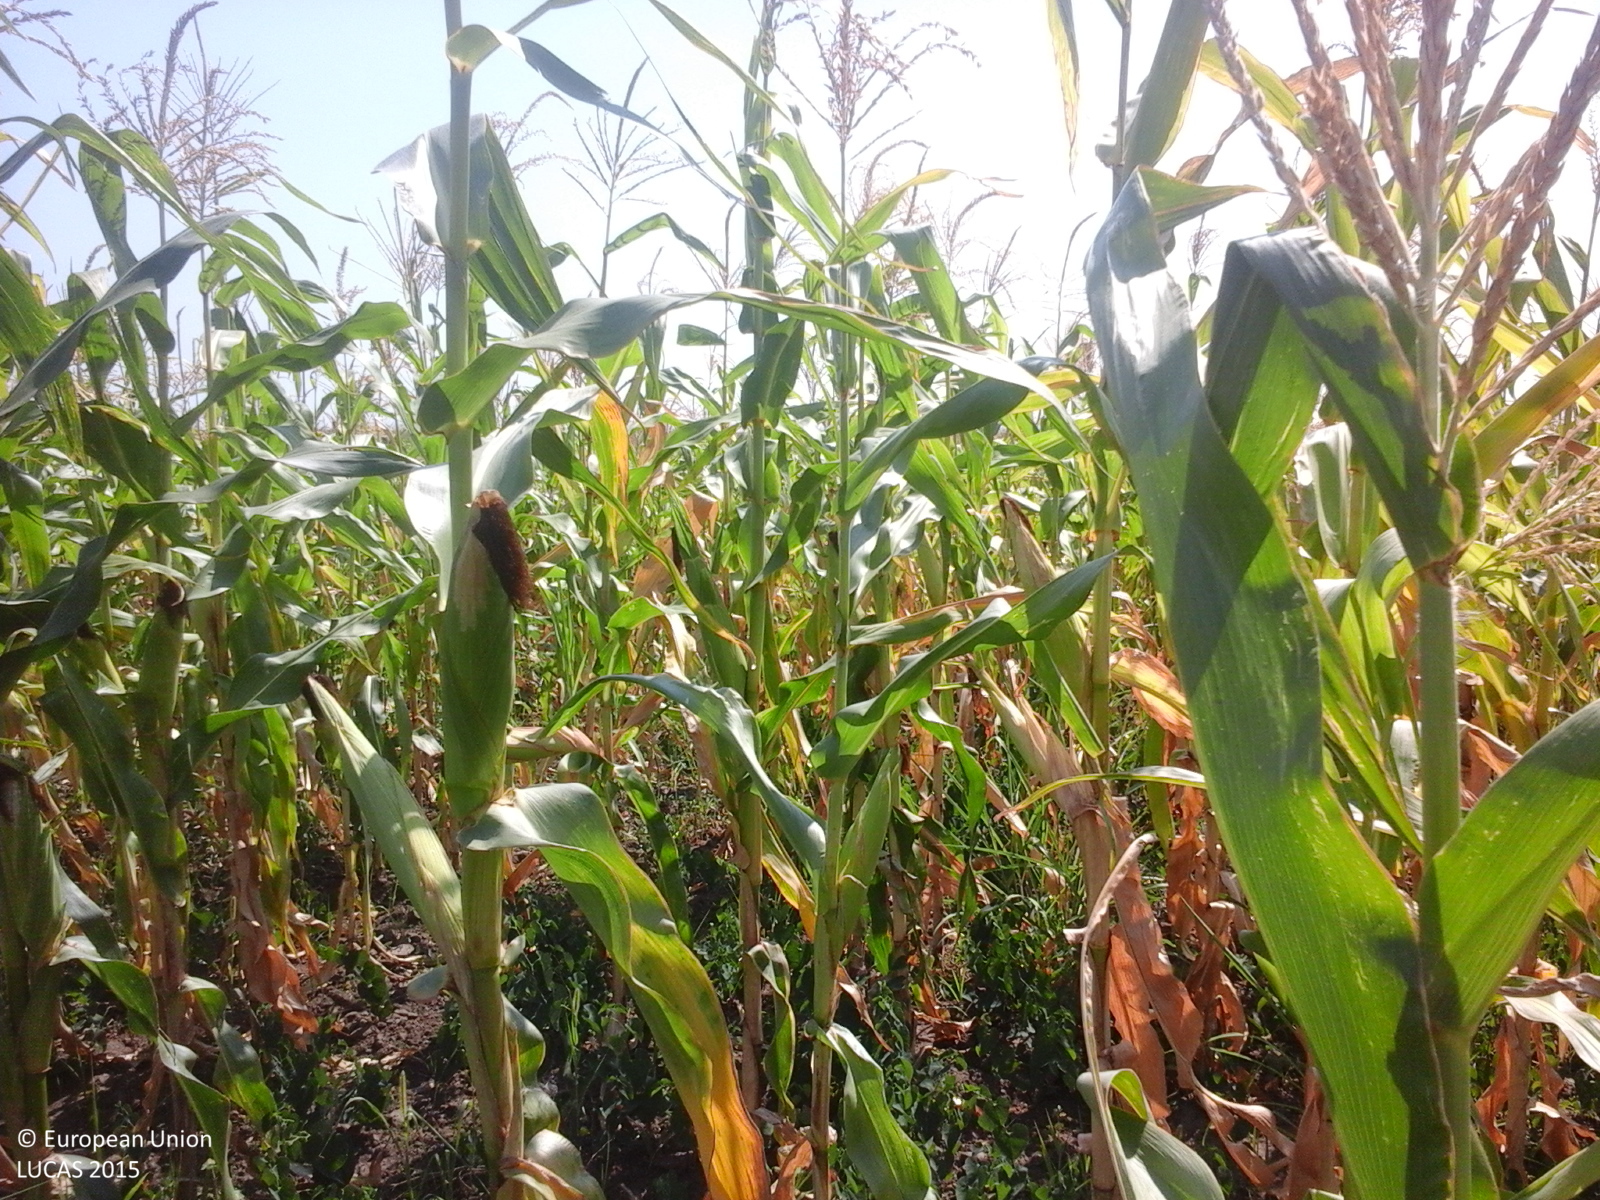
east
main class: Cropland
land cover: Maize
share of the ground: > 75 %
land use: Agriculture (excluding fallow land and kitchen gardens)
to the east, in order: Maize; Sunflower; Maize; Sunflower; Maize; Sunflower; Maize; Grass margins; Tracks; Abandoned hedges; Railways; Spontaneously vegetated surfaces; Tracks; Maize; Electric lines; Maize
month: August
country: RO
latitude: 45.7546
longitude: 27.4188
